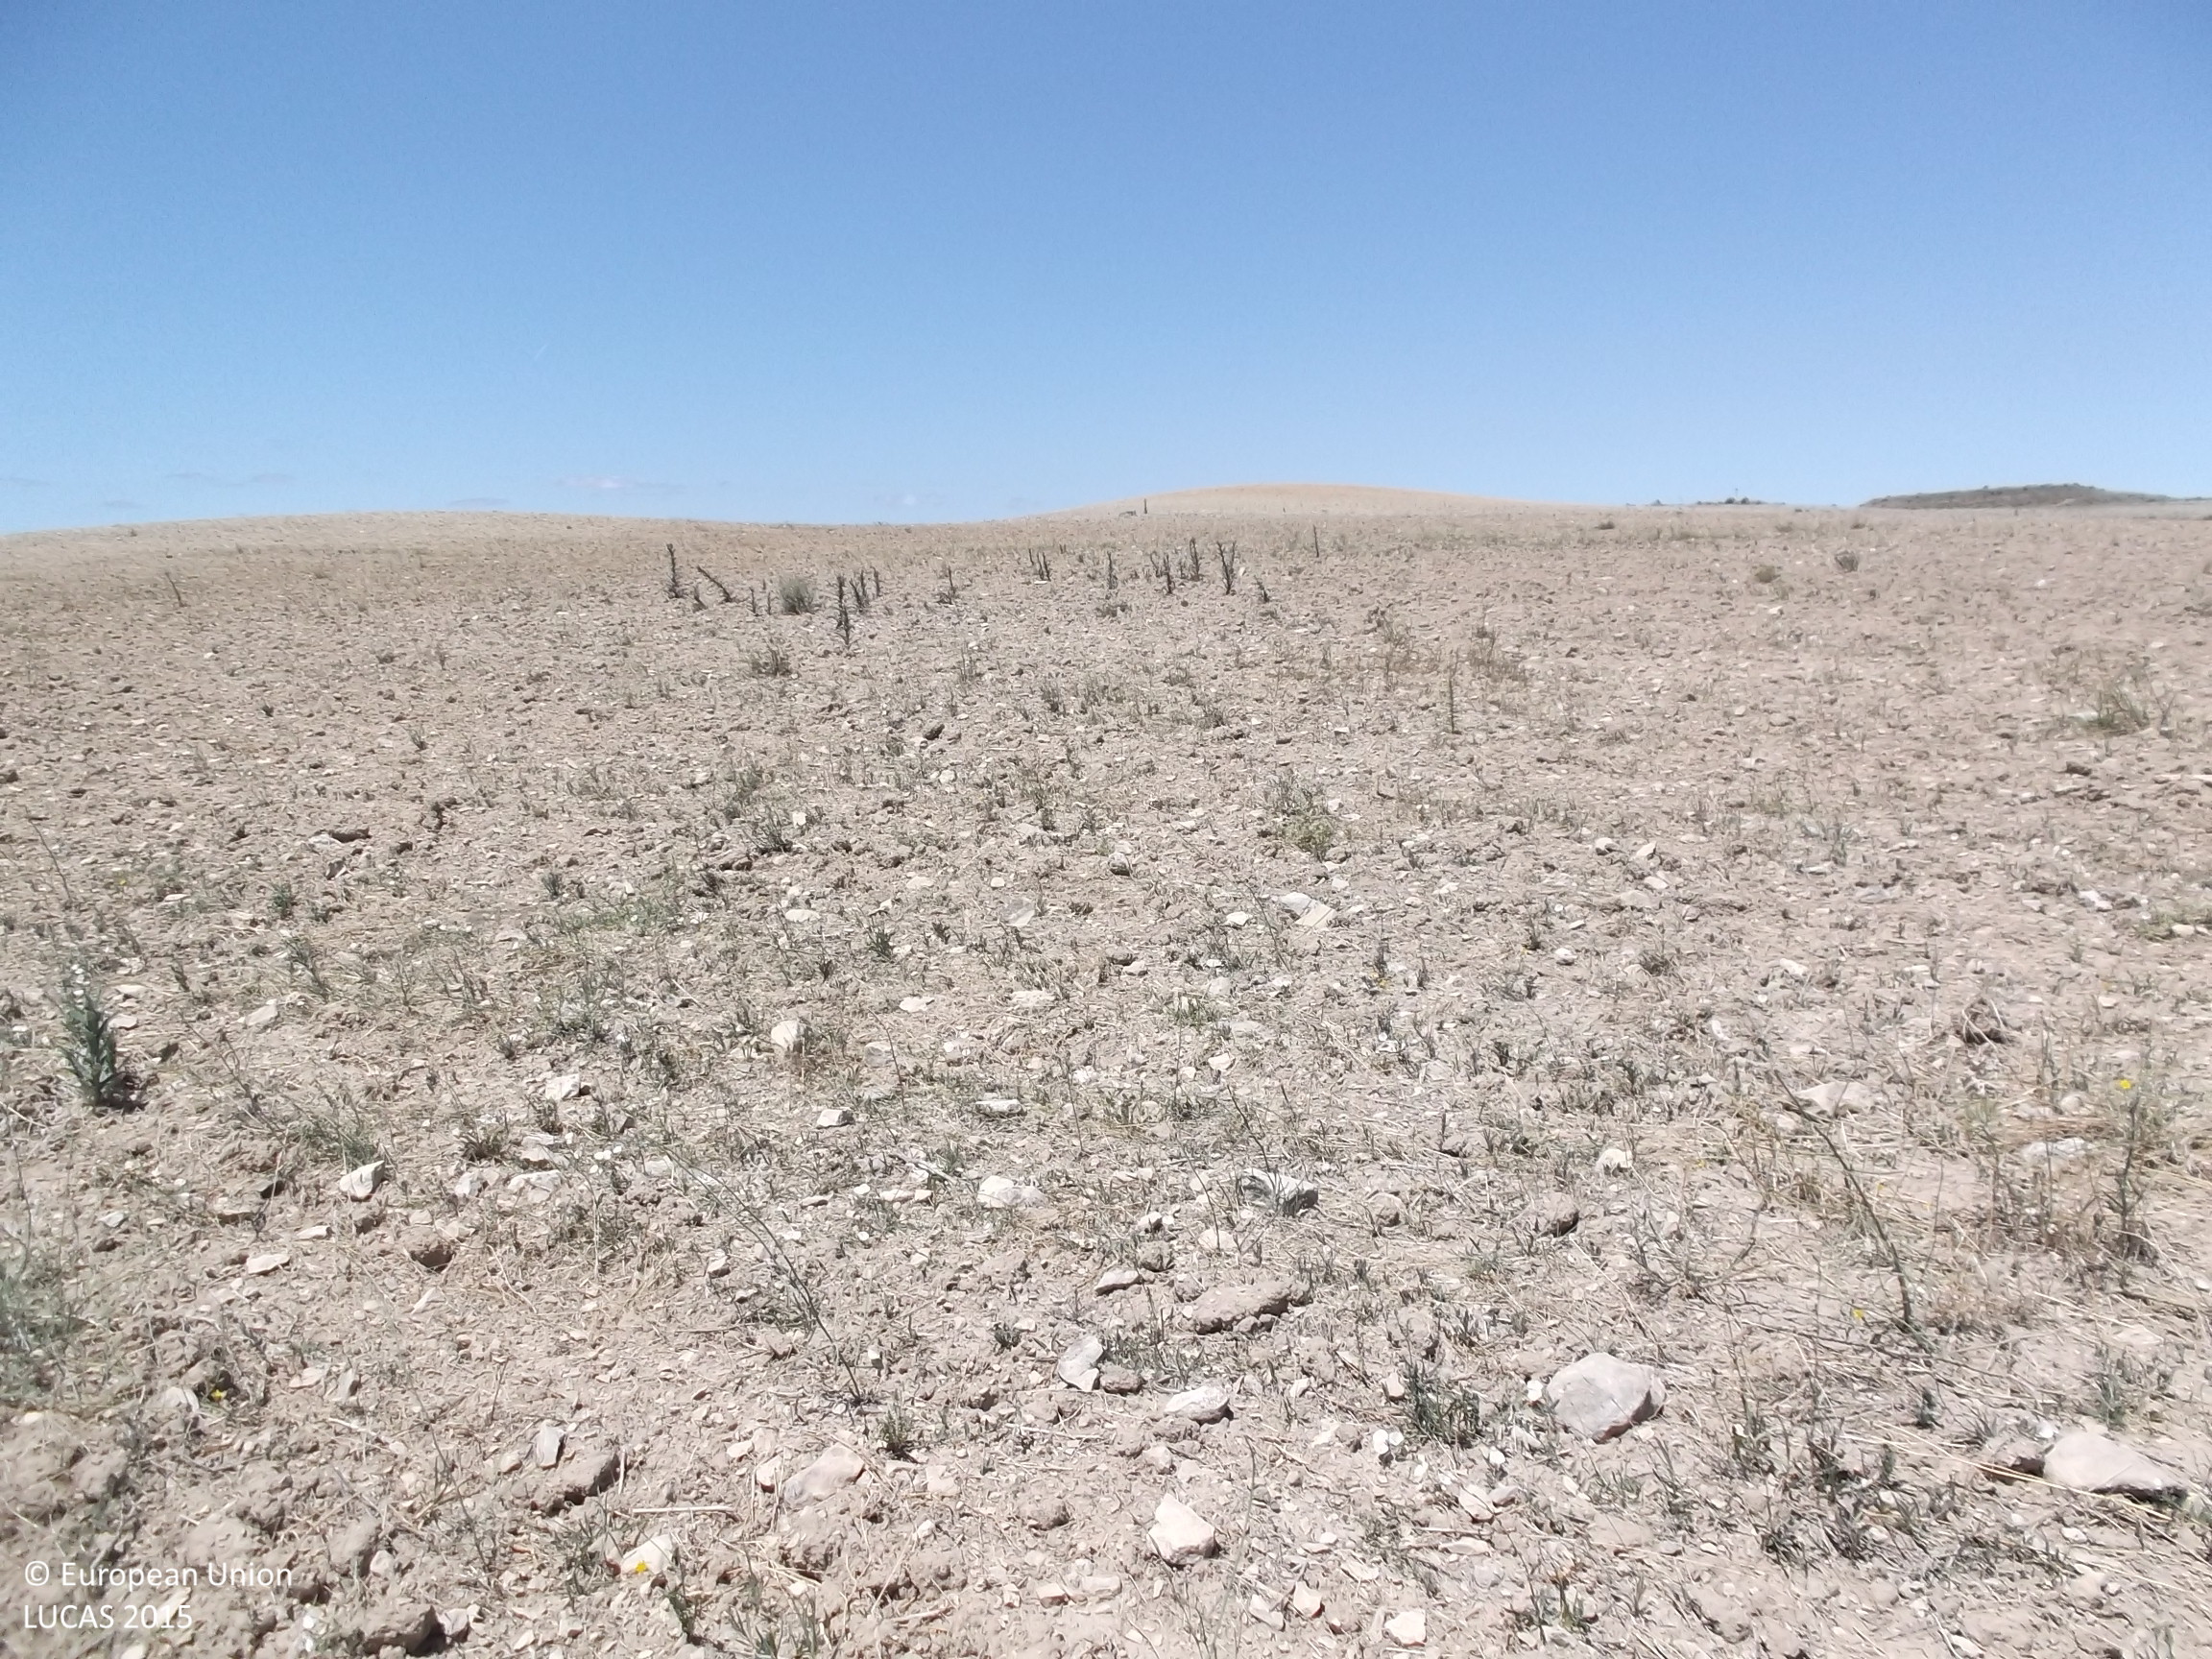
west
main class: Grassland
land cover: Spontaneously vegetated surfaces
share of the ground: 10 - 25 %
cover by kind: unconsolidated bare surface 75 %, herbaceous plants 20 %
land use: Fallow land
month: July
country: ES
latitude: 42.1203
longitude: -1.5346
